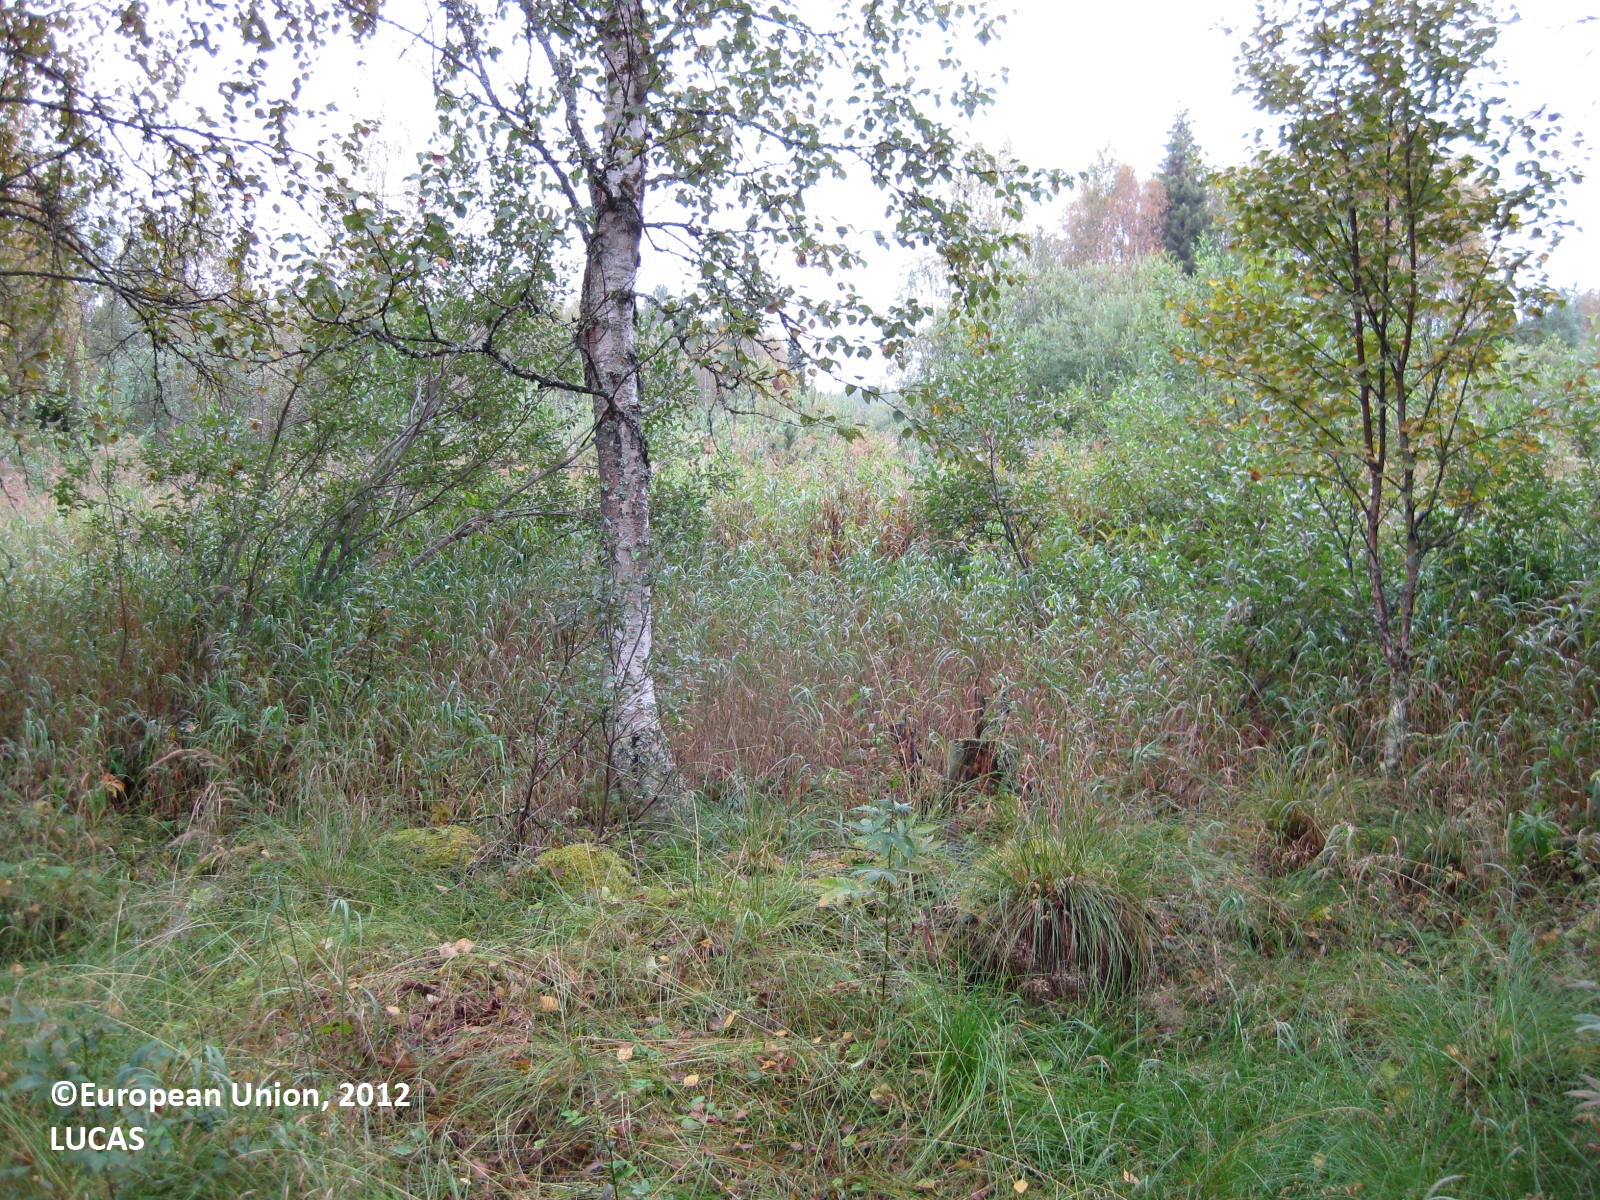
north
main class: Woodland
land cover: Pine dominated mixed woodland
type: boreal forest
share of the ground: 50 - 75 %
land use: Forestry
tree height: > 5 m
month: August
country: FI
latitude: 66.0889
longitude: 28.7560
